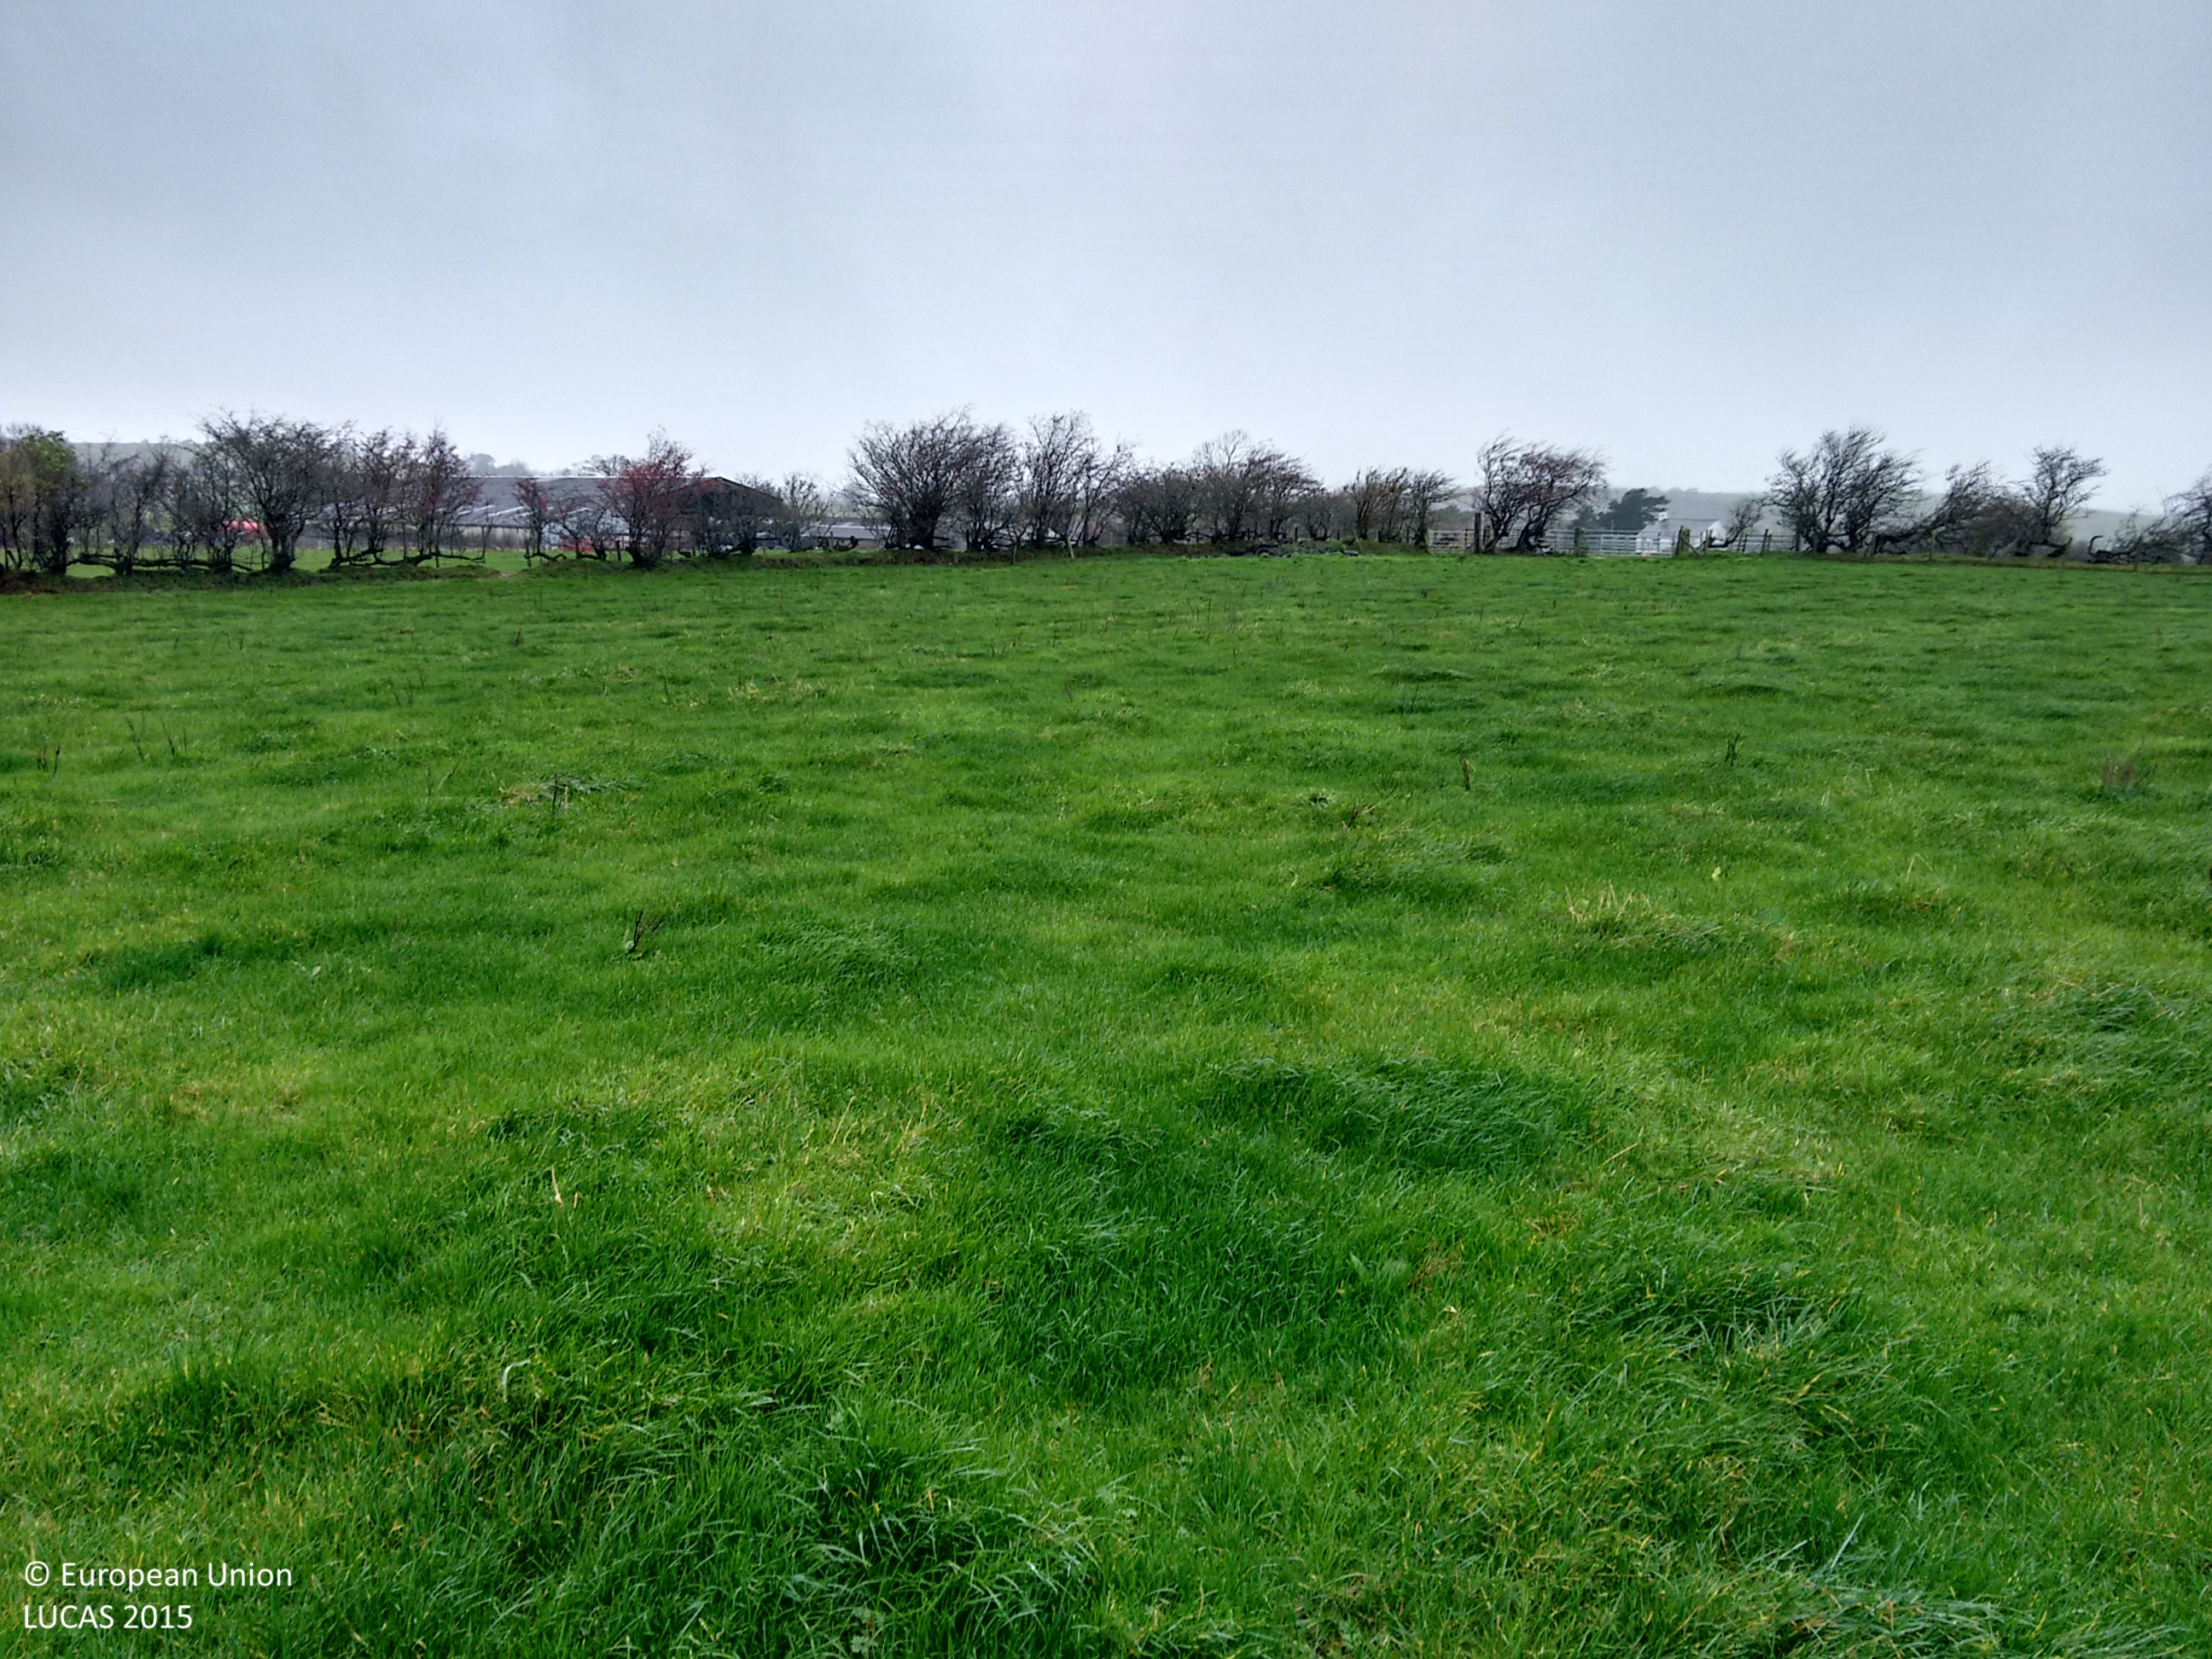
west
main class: Grassland
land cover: Grassland without tree/shrub cover
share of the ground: > 75 %
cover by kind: herbaceous plants 100 %
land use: Agriculture (excluding fallow land and kitchen gardens)
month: November
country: GB
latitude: 54.5651
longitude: -3.4275
